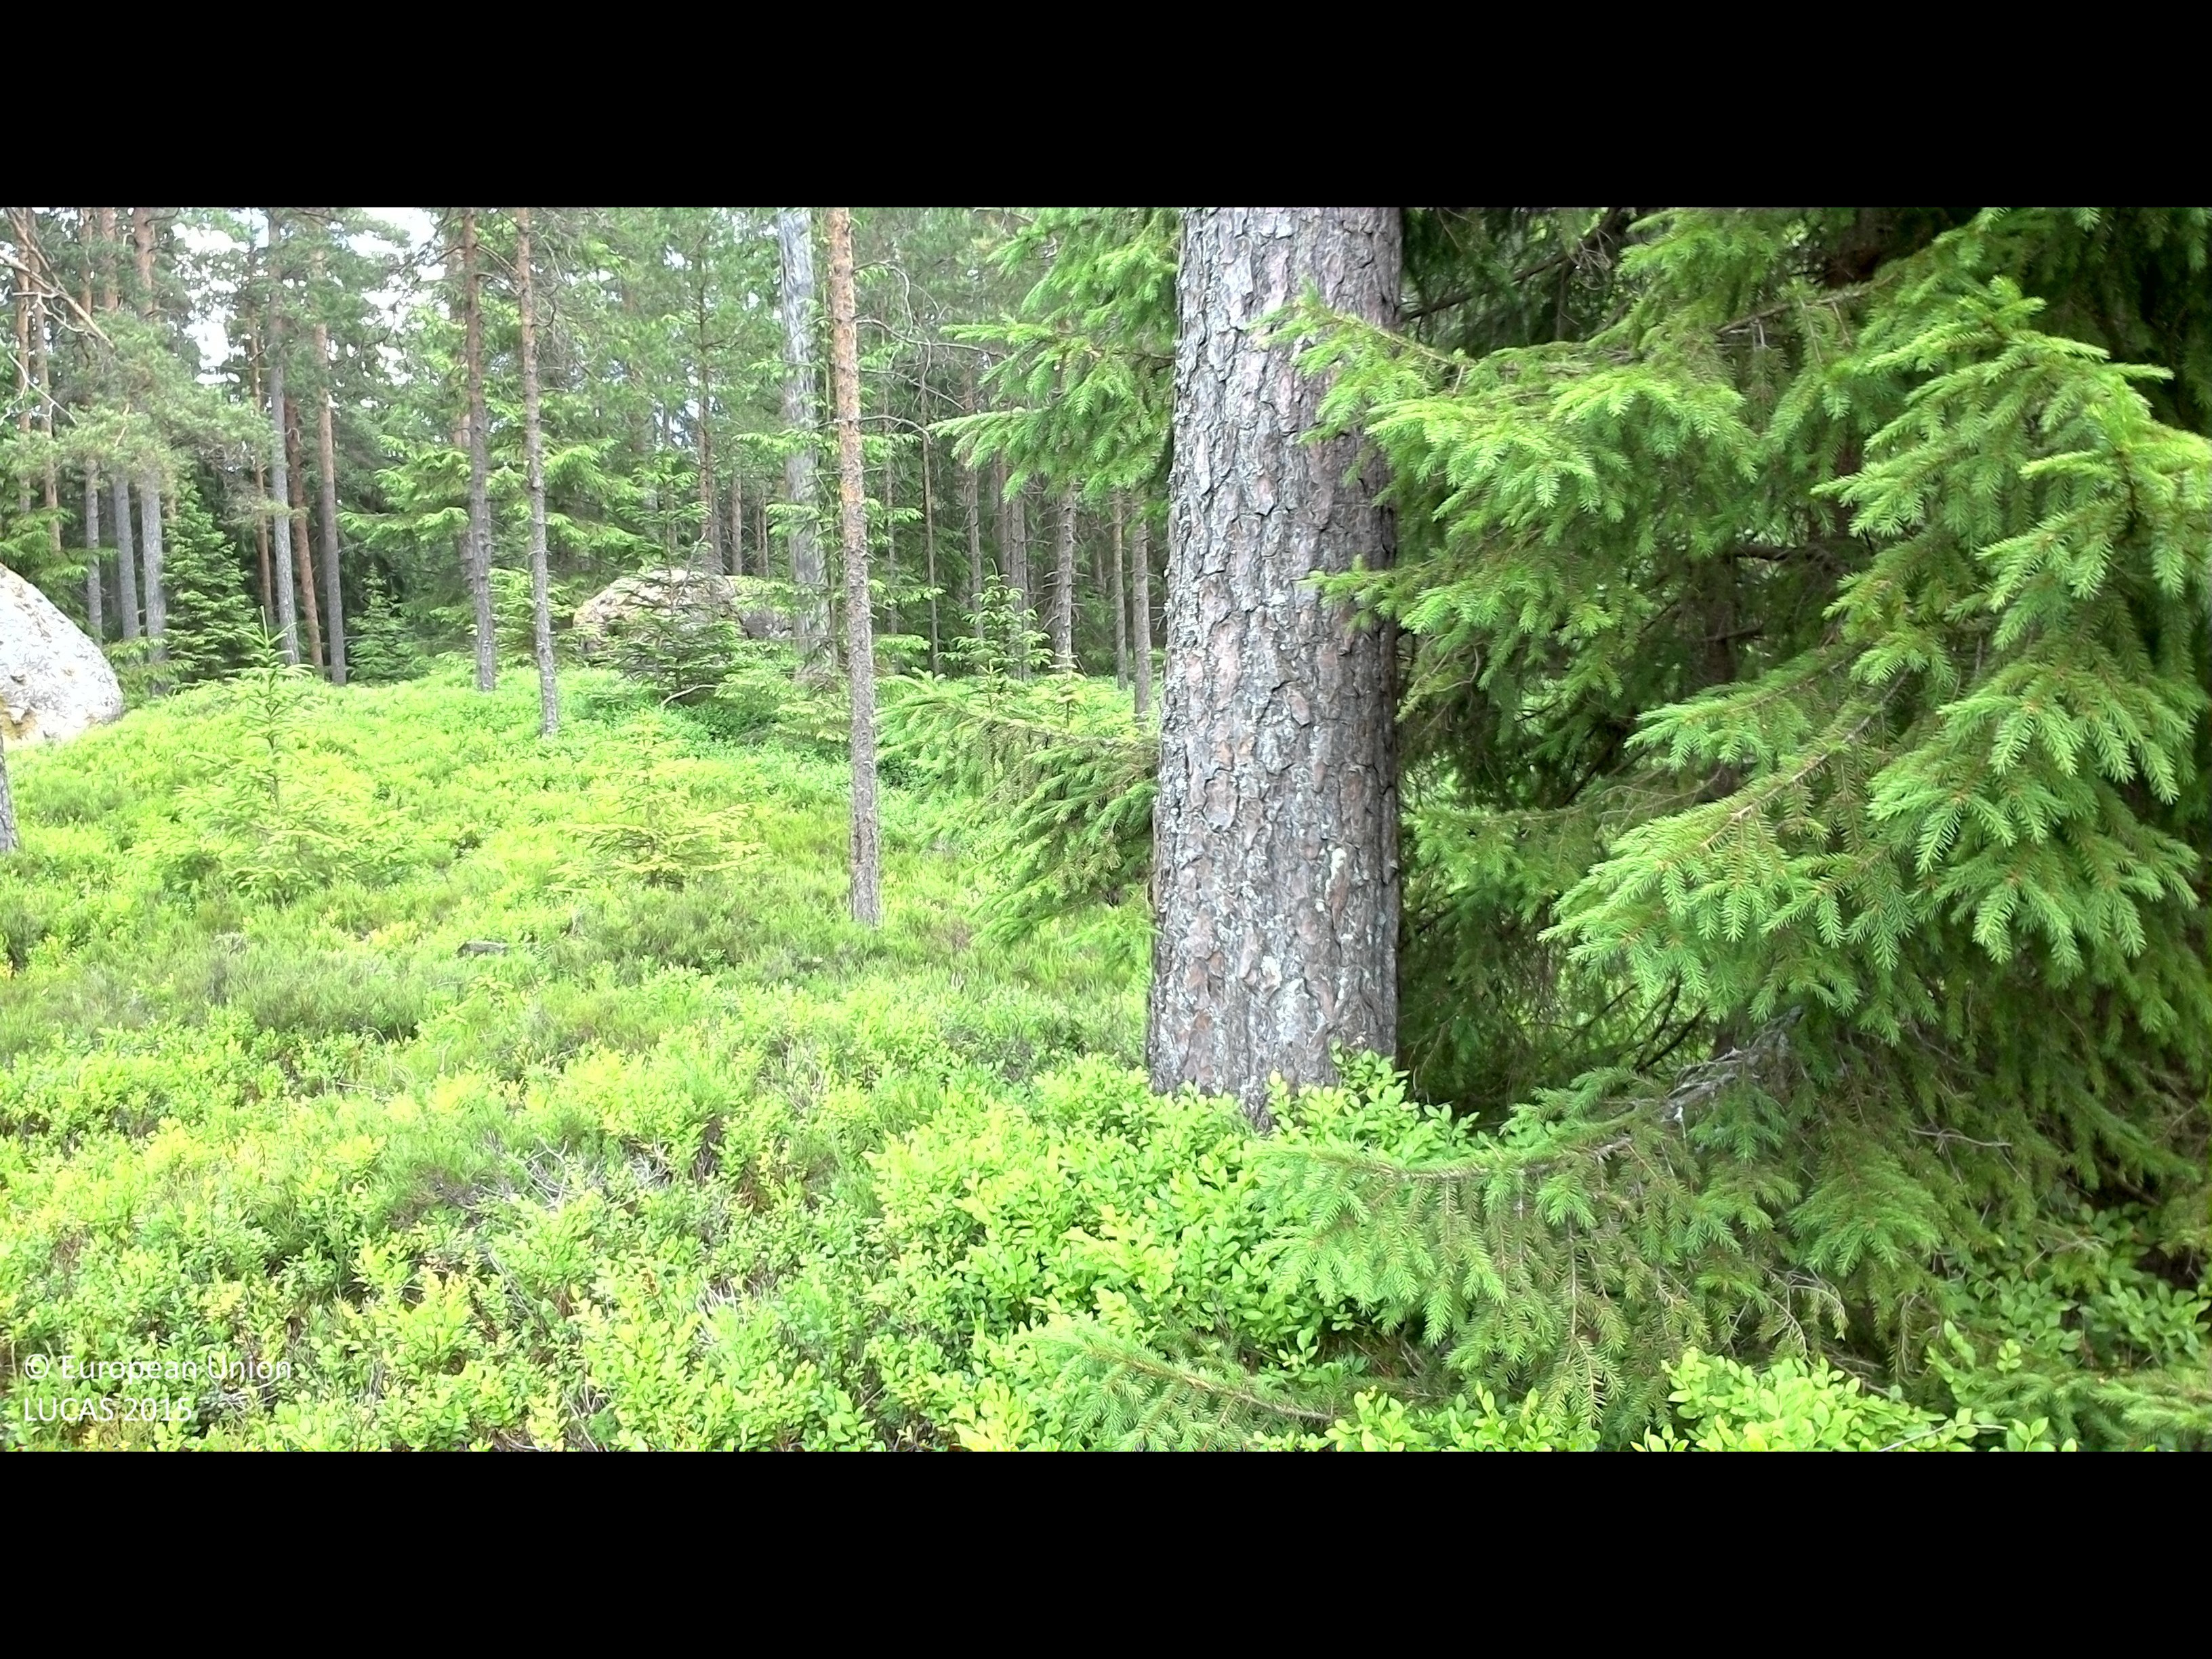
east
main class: Woodland
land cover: Pine dominated coniferous woodland
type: boreal forest
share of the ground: 50 - 75 %
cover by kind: coniferous forest trees 50 %, shrubs 35 %, lichens and mosses 15 %
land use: Forestry
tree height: > 5 m
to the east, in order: Pine dominated coniferous woodland; Spruce dominated coniferous woodland; Ditches and canals; Spruce dominated coniferous woodland; Groves; Paved roads, cycling and walking lanes; Groves; Ditches and canals; Broadleaved woodland
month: July
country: SE
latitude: 56.4055
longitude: 15.2329
